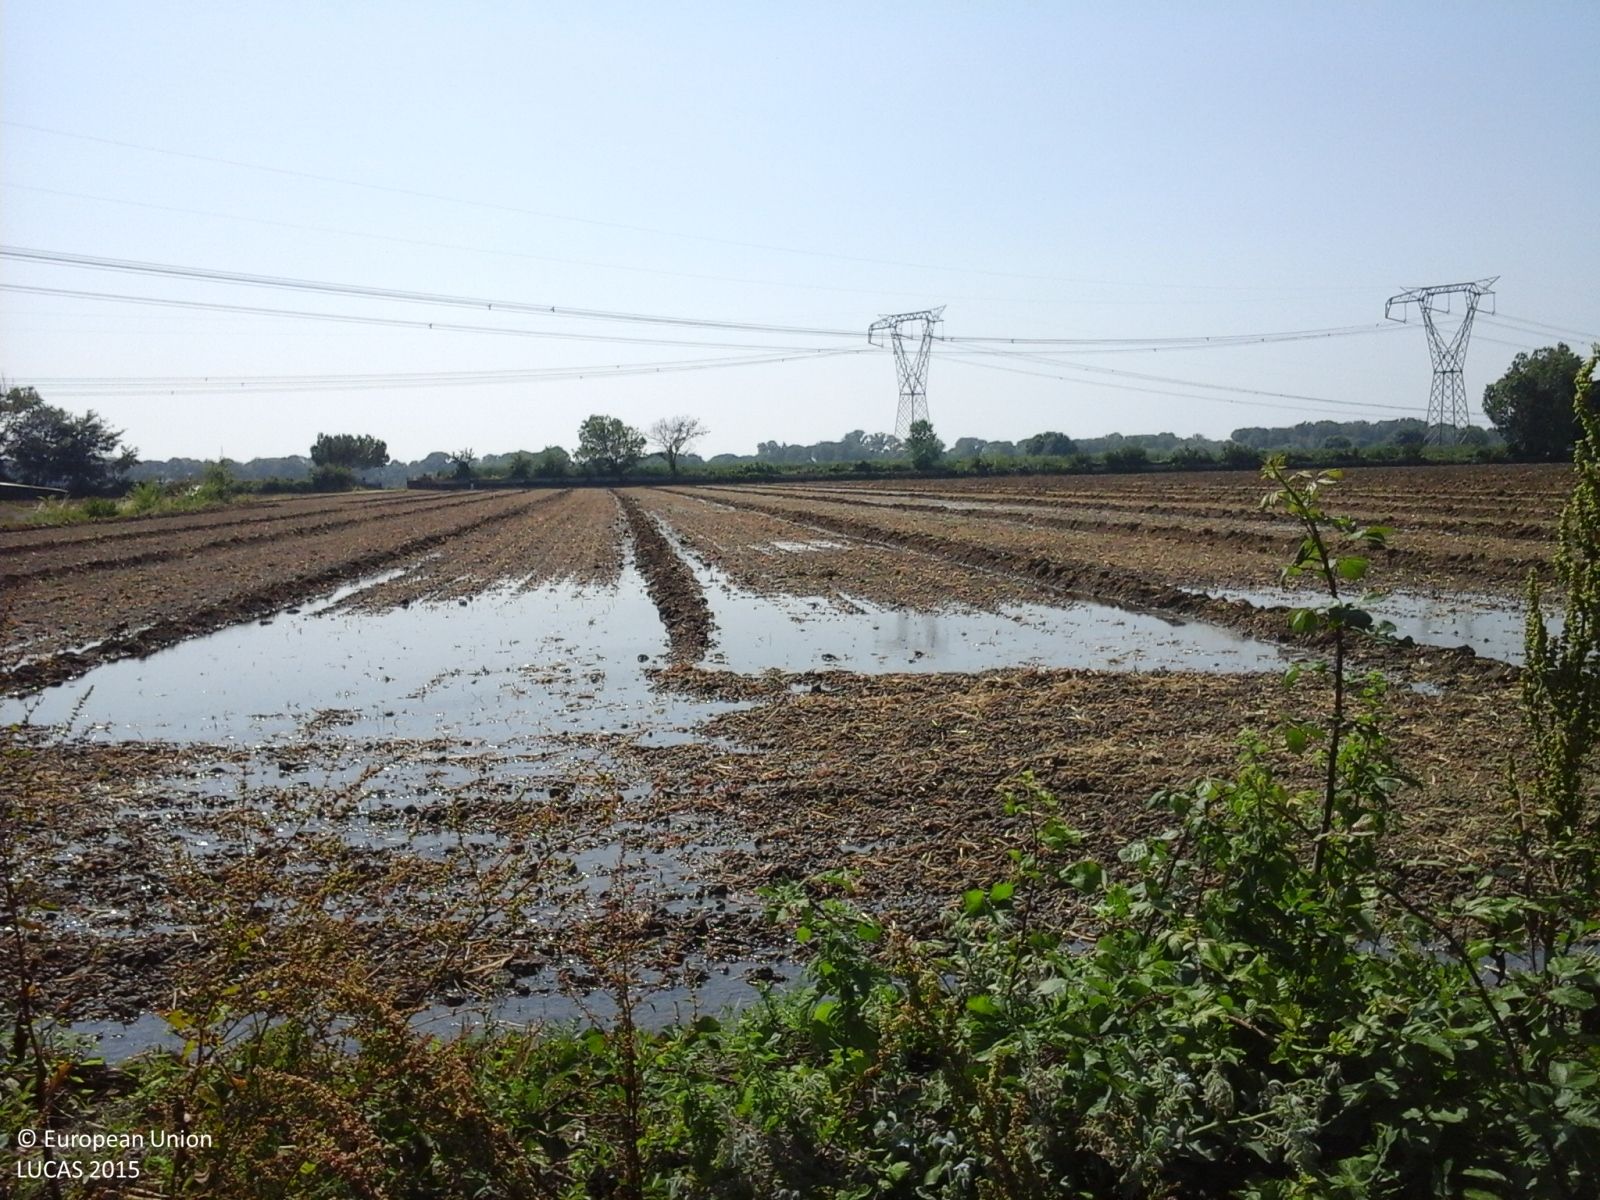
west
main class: Cropland
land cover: Lucerne
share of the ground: > 75 %
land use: Agriculture (excluding fallow land and kitchen gardens)
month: June
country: IT
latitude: 40.5364
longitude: 15.0436
